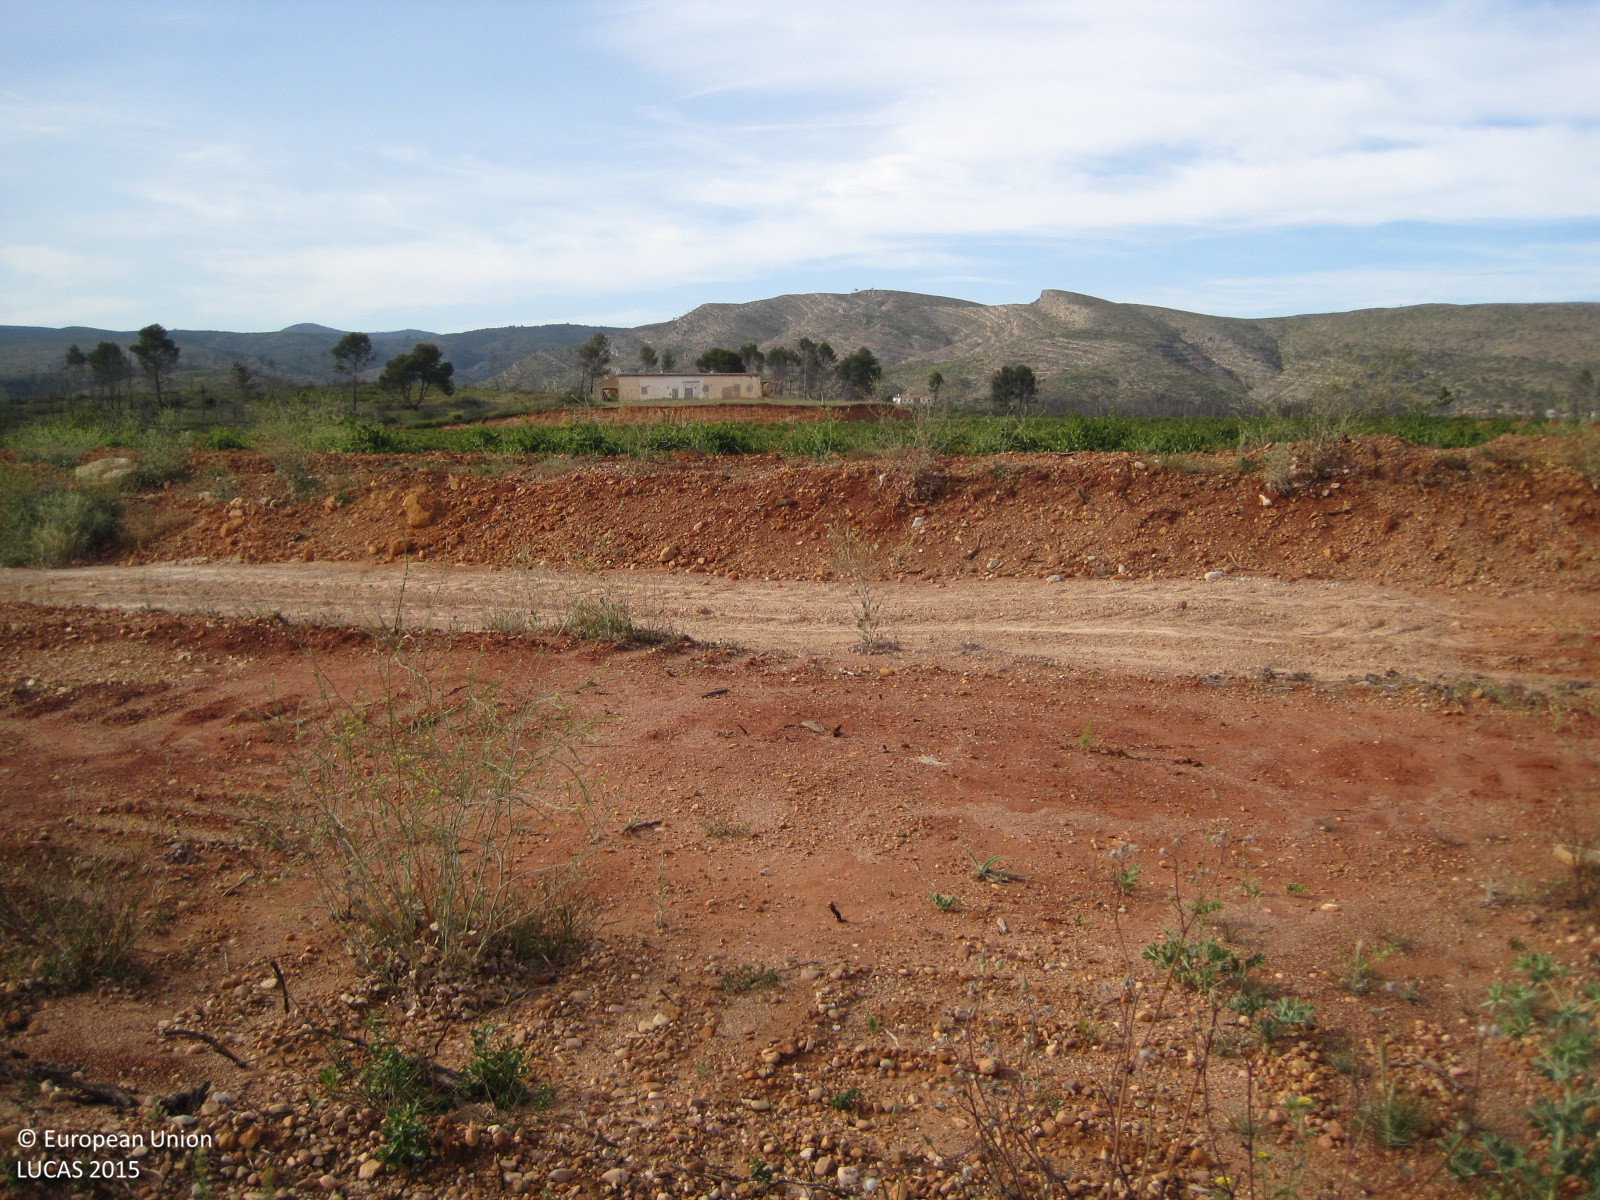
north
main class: Grassland
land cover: Spontaneously vegetated surfaces
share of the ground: 10 - 25 %
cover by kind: unconsolidated bare surface 85 %, herbaceous plants 15 %
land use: Abandoned areas
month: May
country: ES
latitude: 39.3332
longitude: -0.8686
